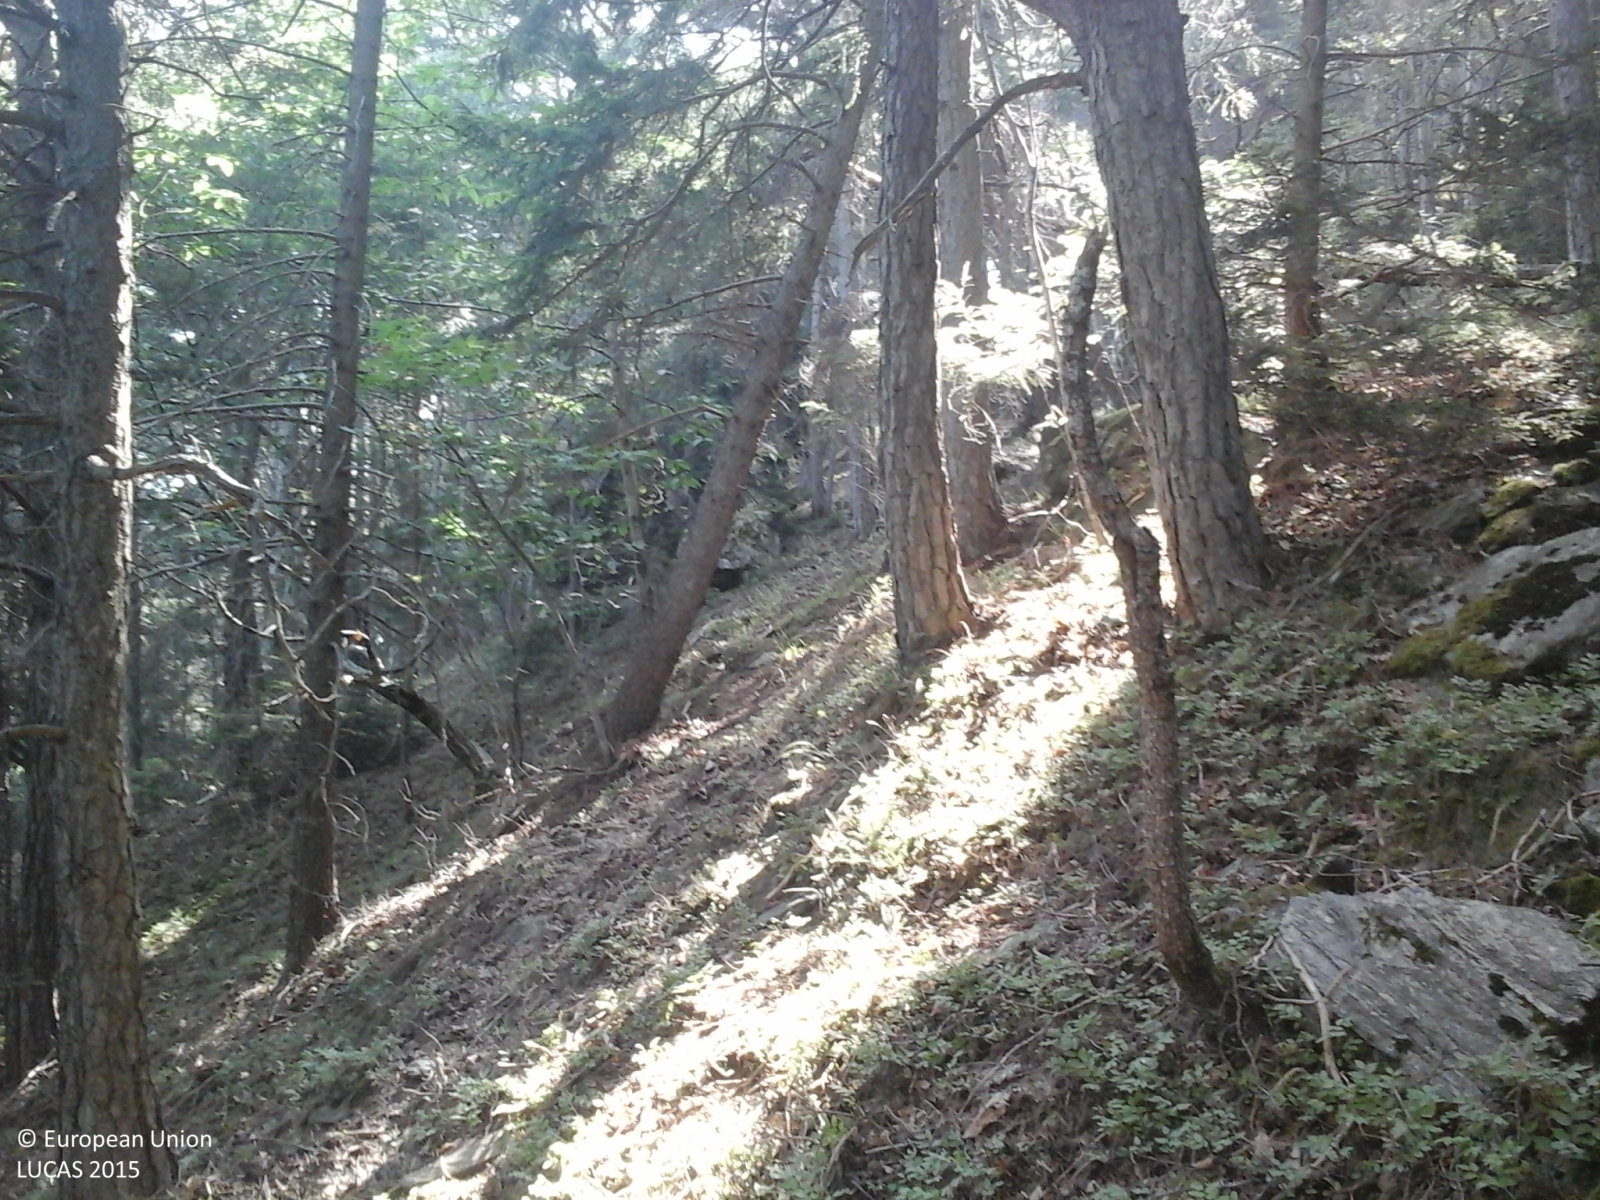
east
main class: Woodland
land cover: Pine dominated mixed woodland
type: alpine coniferous forest
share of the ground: > 75 %
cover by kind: coniferous forest trees 70 %, broadleaved forest trees 30 %
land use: Forestry
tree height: > 5 m
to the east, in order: Pine dominated mixed woodland
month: July
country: IT
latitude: 45.7290
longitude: 7.5748
